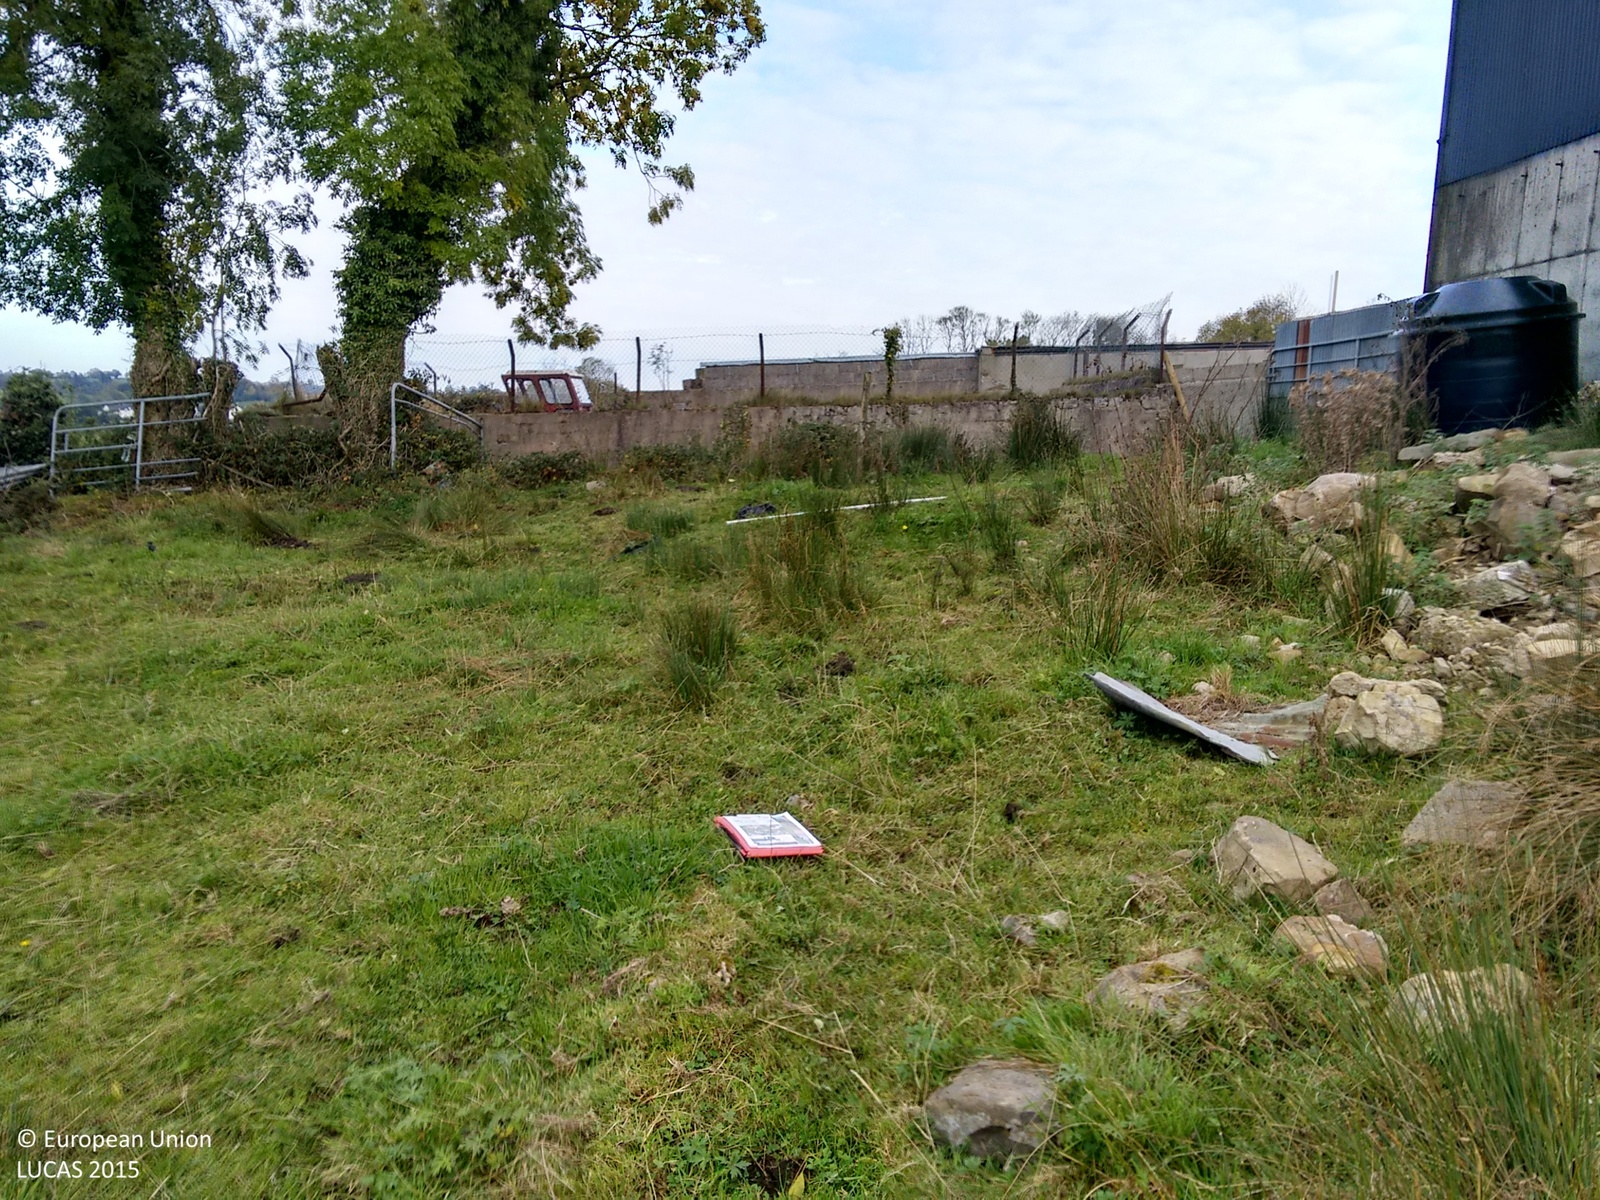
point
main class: Grassland
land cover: Grassland without tree/shrub cover
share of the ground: > 75 %
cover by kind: herbaceous plants 100 %
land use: Agriculture (excluding fallow land and kitchen gardens)
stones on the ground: < 10 %
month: October
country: GB
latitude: 54.2271
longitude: -7.6642
